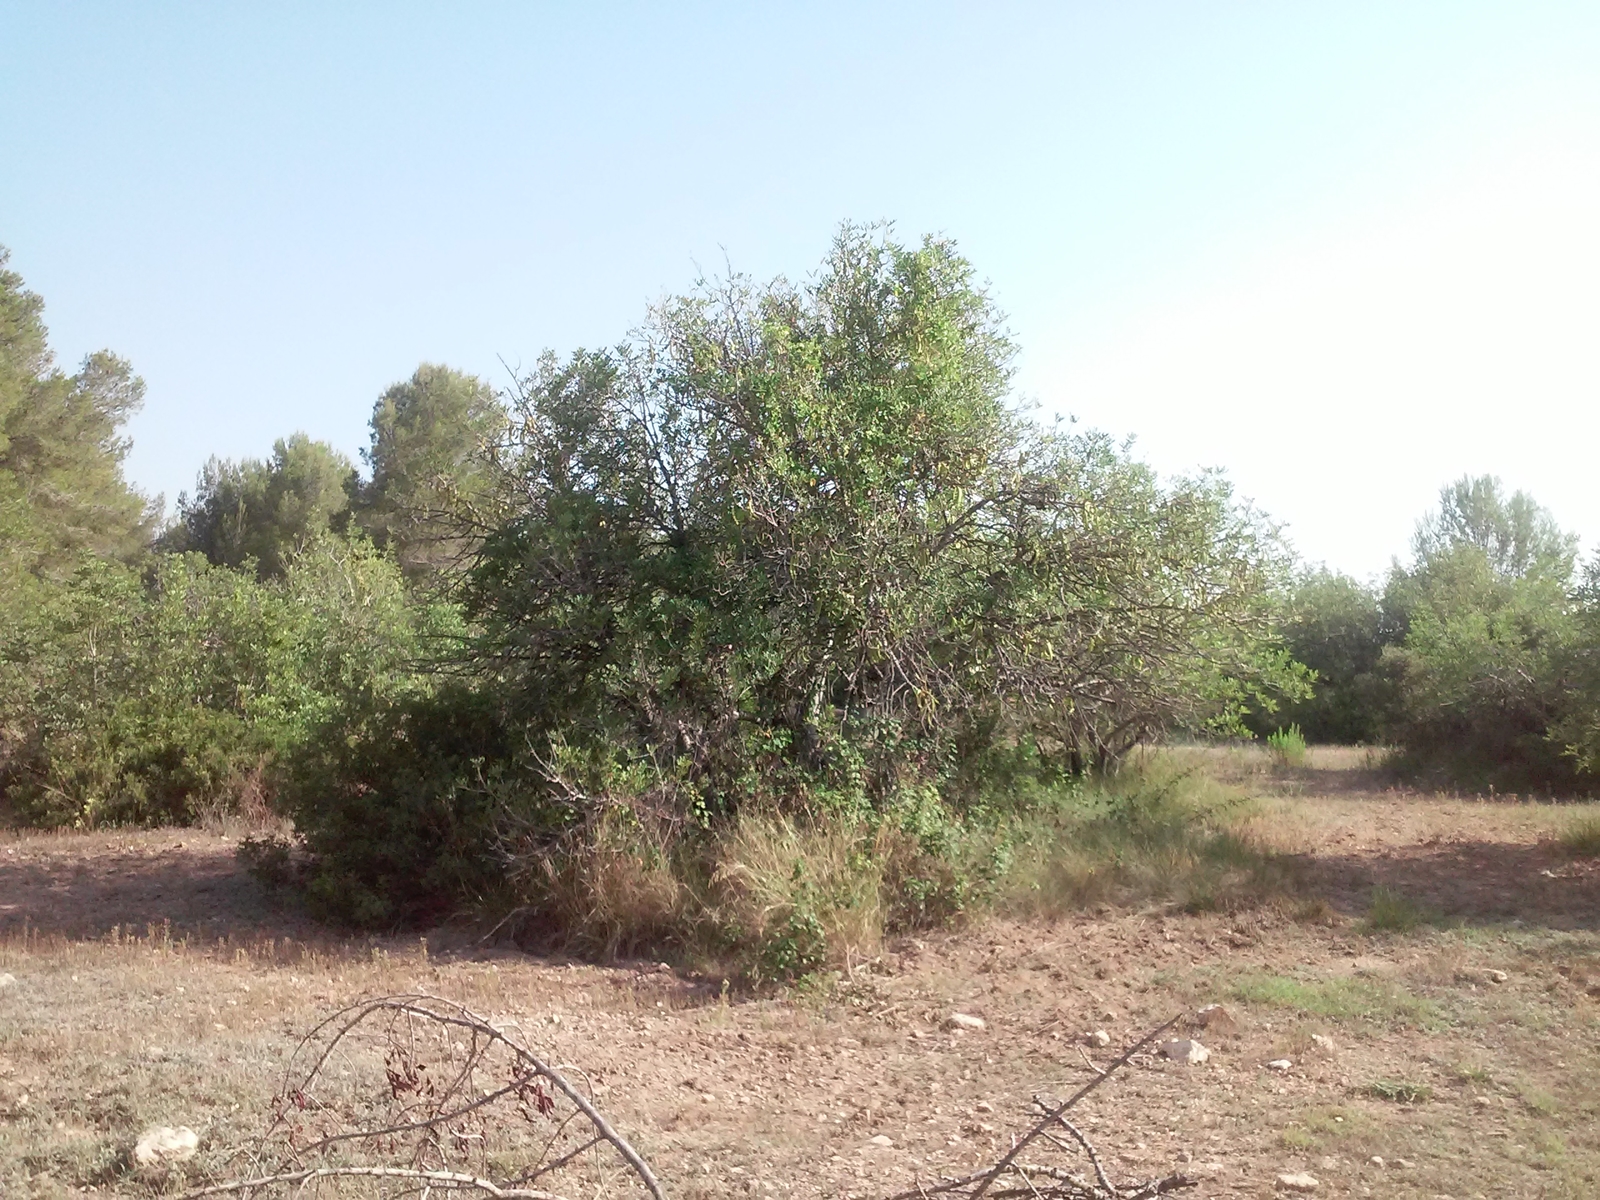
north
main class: Cropland
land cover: Permanent industrial crops
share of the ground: 10 - 25 %
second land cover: Other bare soil
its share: > 75 %
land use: Agriculture (excluding fallow land and kitchen gardens)
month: July
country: ES
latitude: 41.2212
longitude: 1.2496
